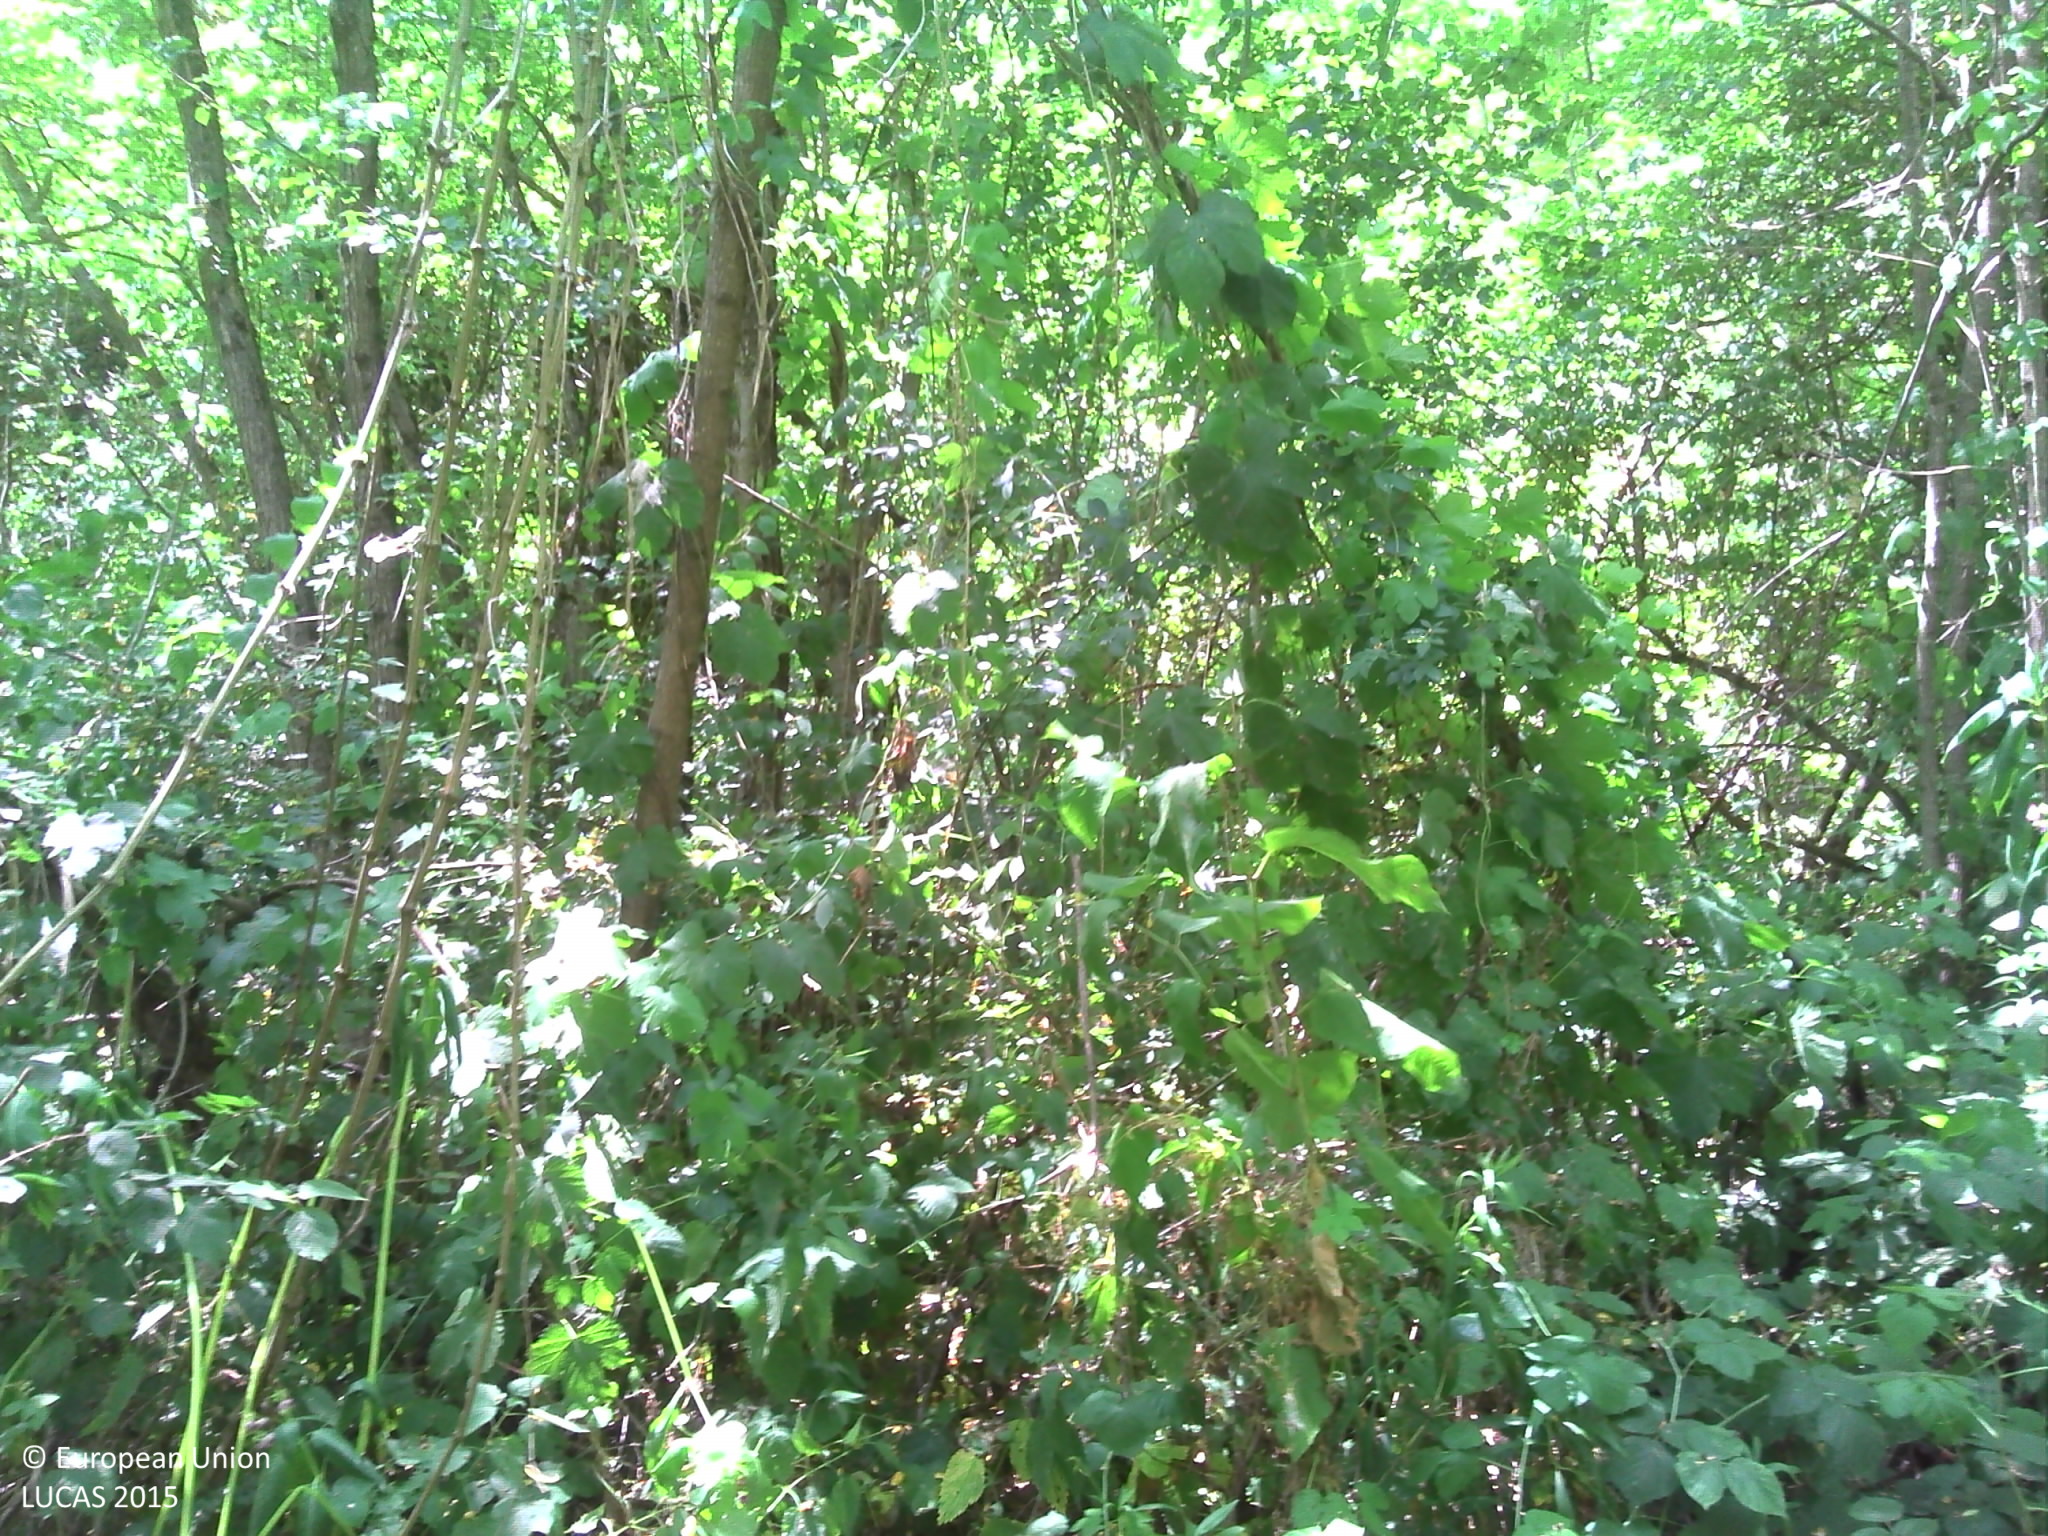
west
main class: Woodland
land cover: Broadleaved woodland
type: floodplain forest
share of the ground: > 75 %
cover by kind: broadleaved forest trees 95 %, coniferous forest trees 5 %
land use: Abandoned areas
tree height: > 5 m
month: July
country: FR
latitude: 44.4714
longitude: 3.2039
